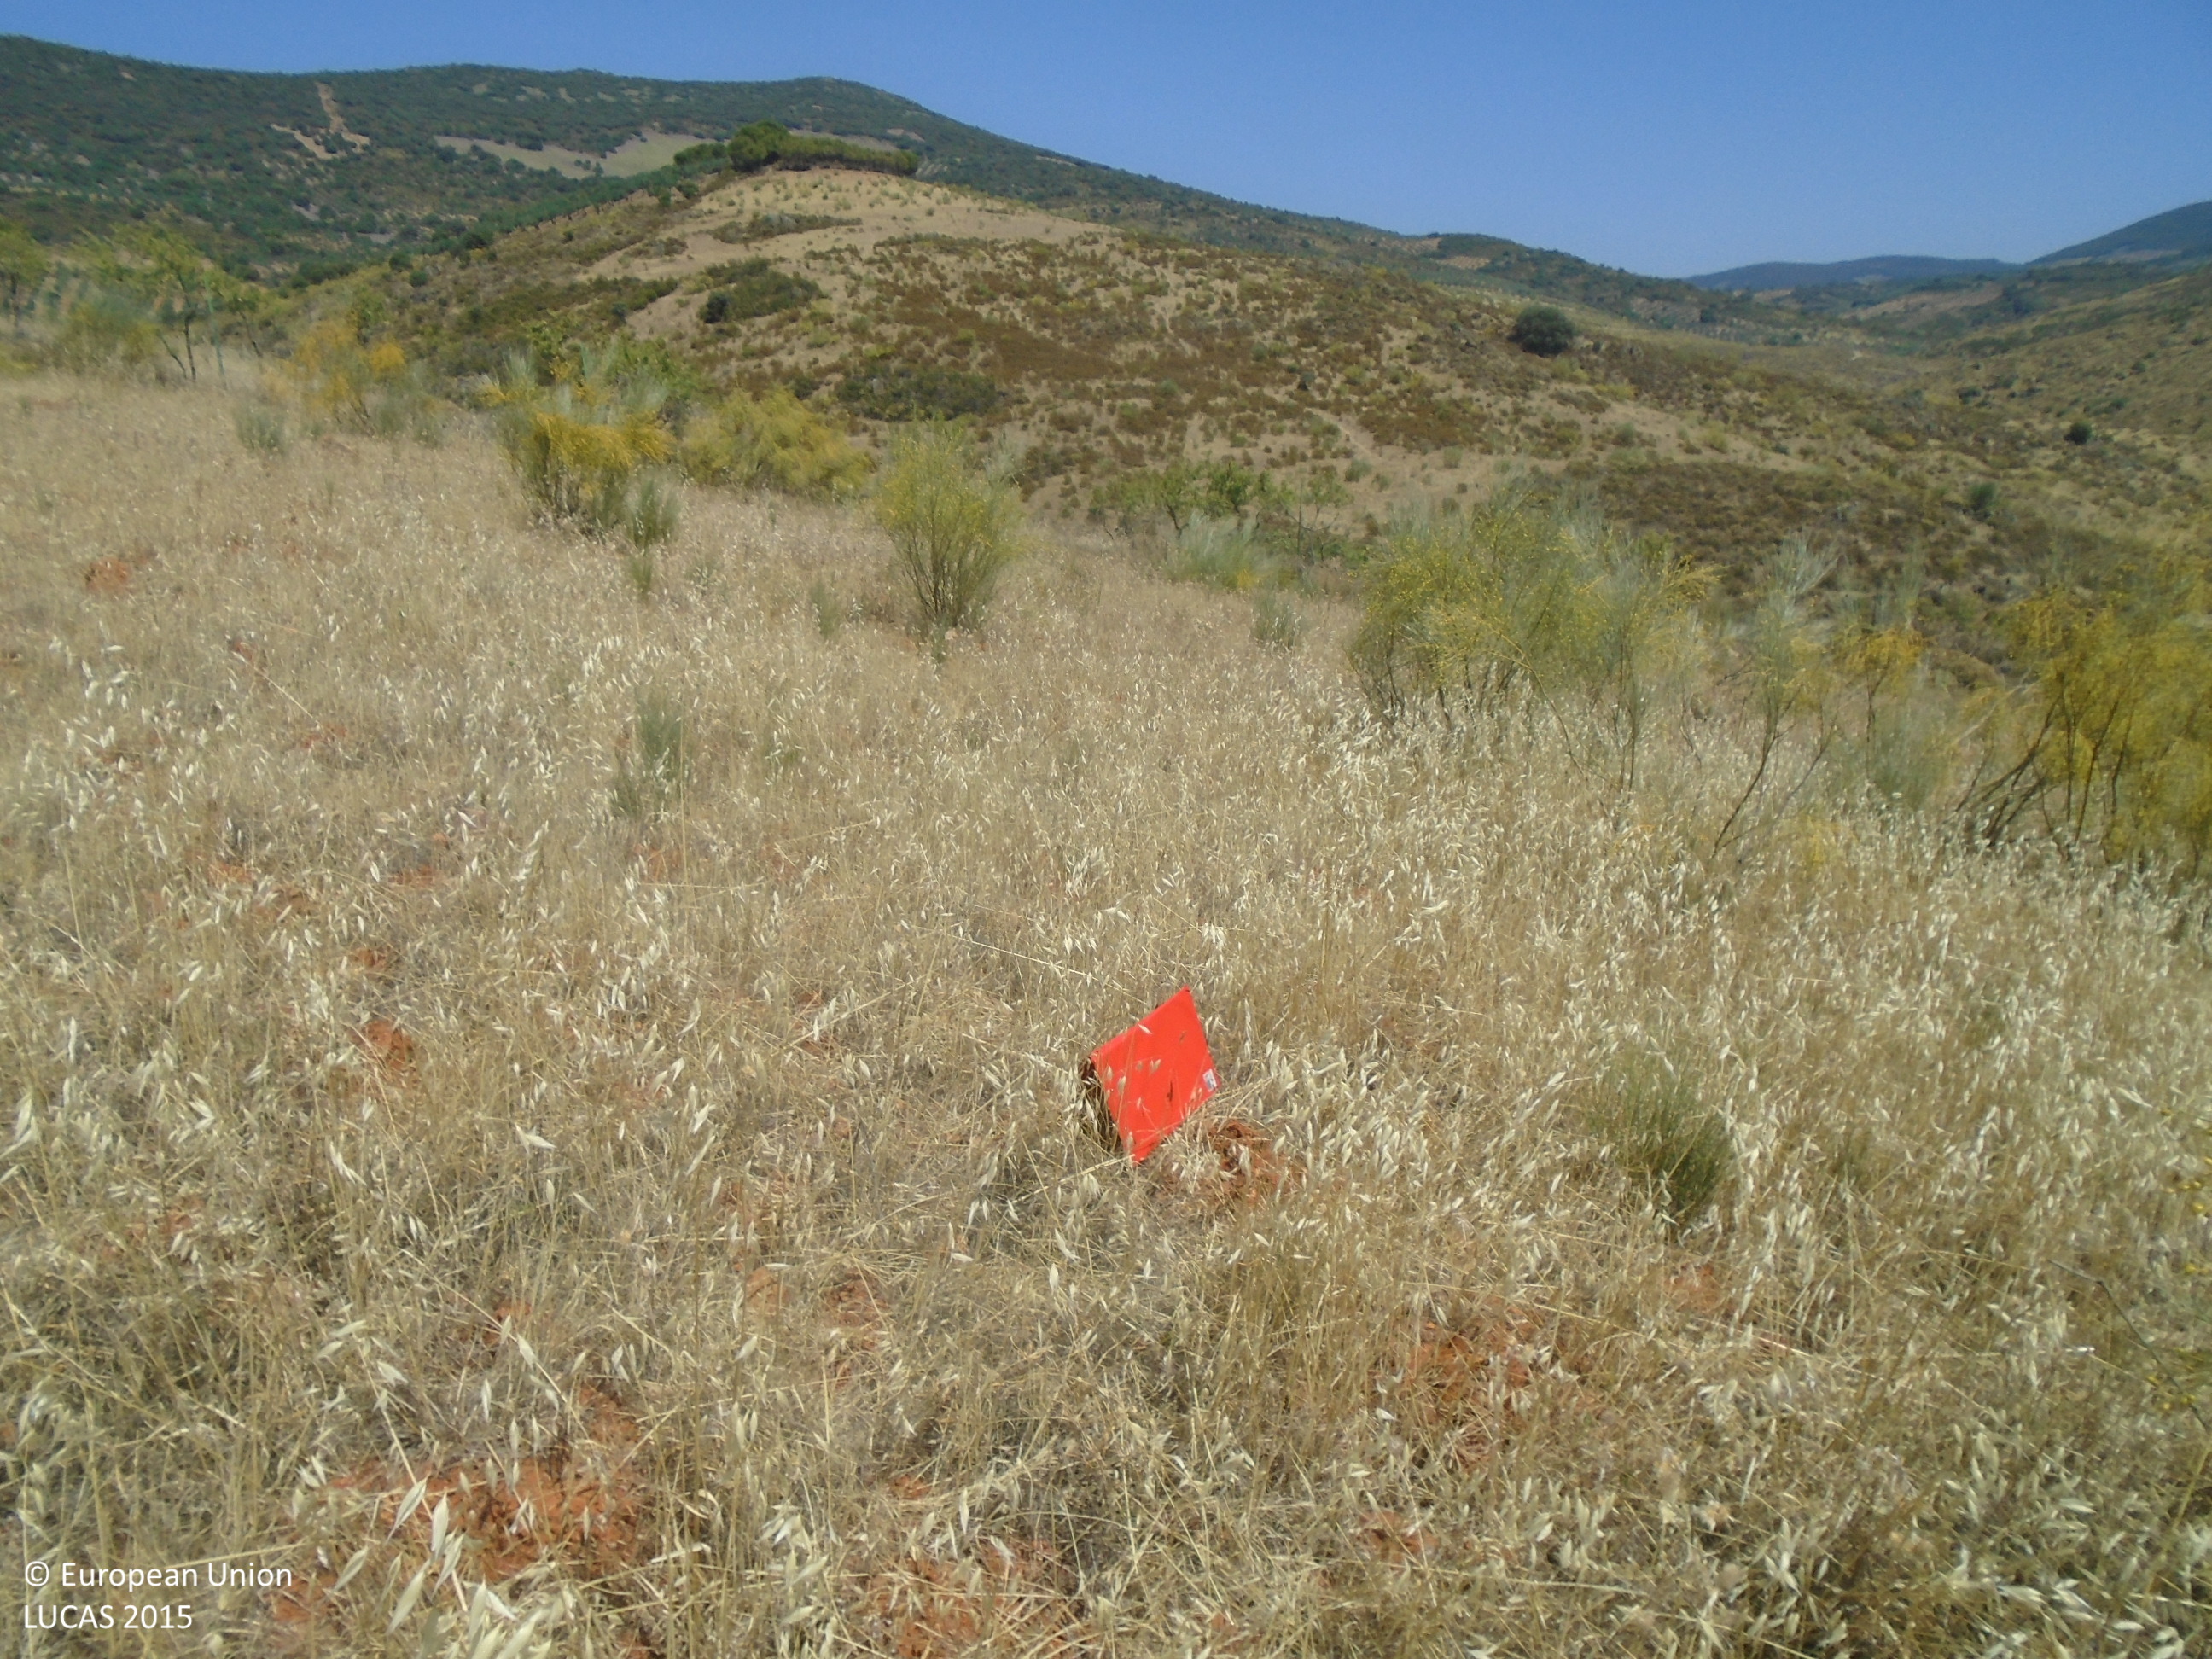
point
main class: Shrubland
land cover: Shrubland without tree cover
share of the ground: > 75 %
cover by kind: herbaceous plants 80 %, shrubs 20 %
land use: Semi-natural and natural areas not in use
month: July
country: ES
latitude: 39.6614
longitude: -4.9769
